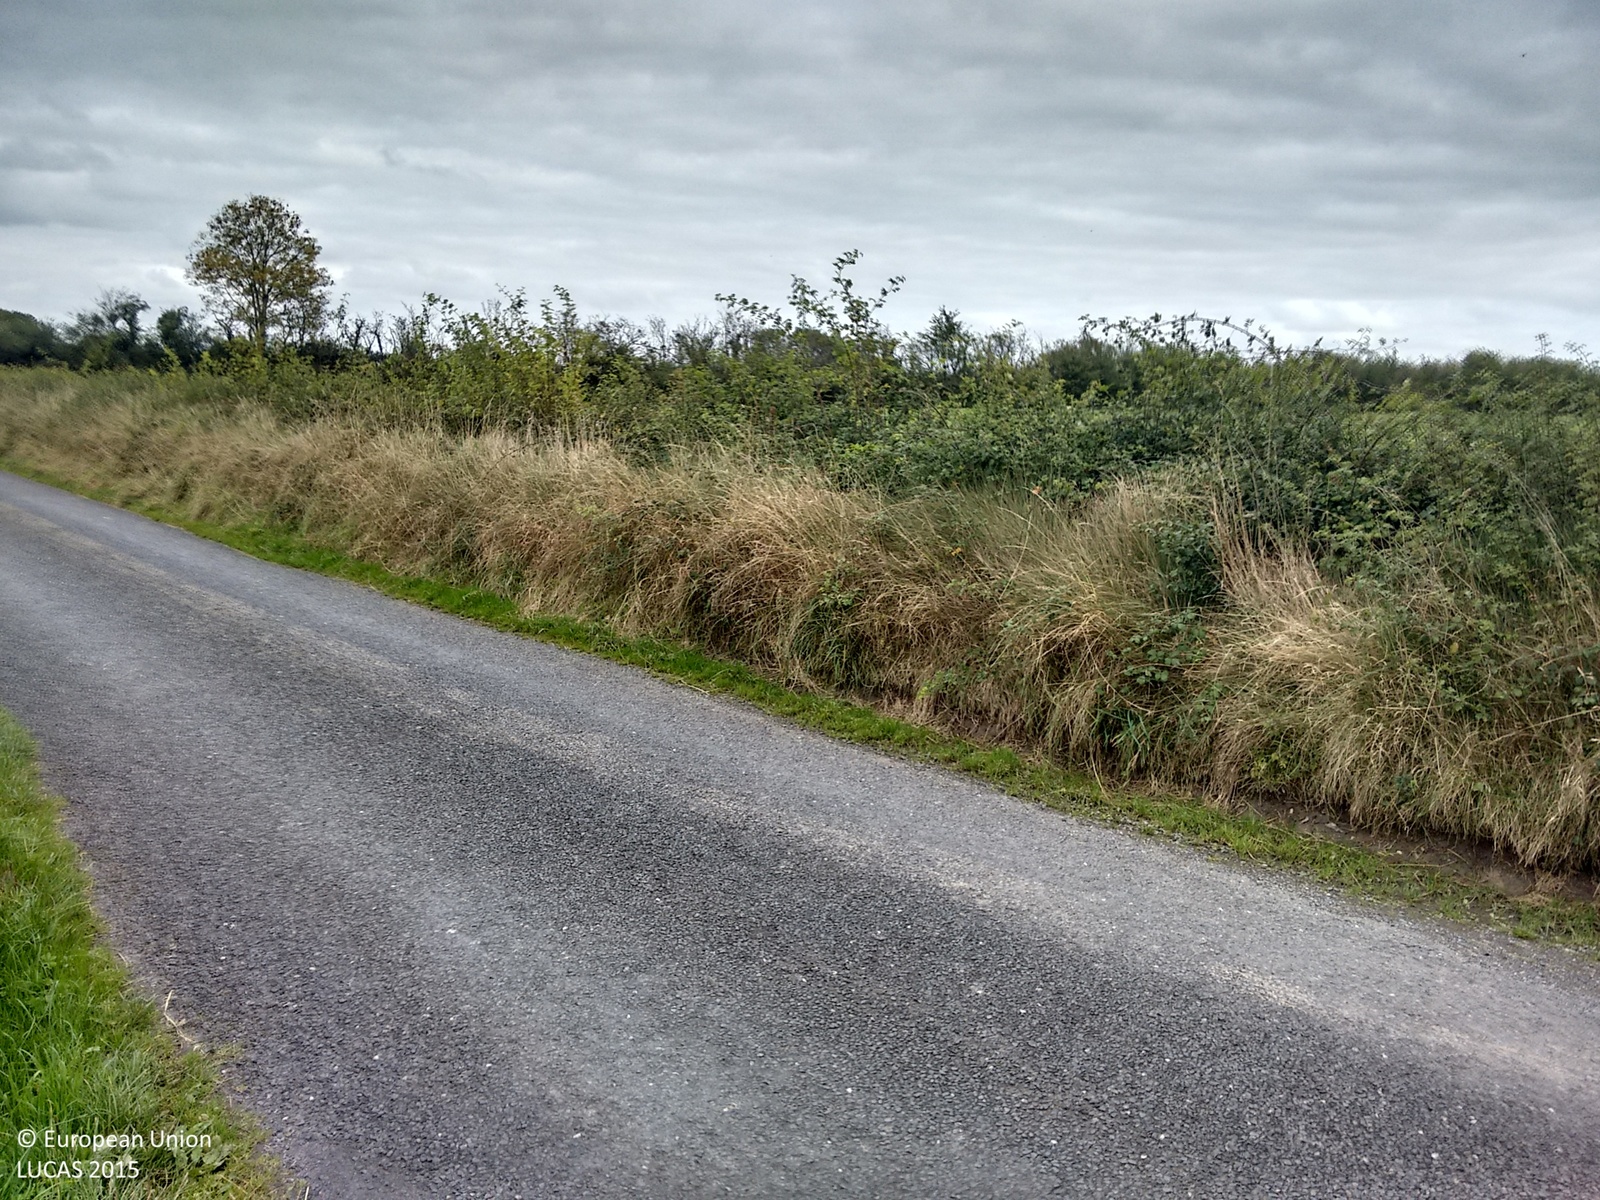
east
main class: Grassland
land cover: Grassland without tree/shrub cover
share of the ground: > 75 %
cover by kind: herbaceous plants 100 %
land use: Agriculture (excluding fallow land and kitchen gardens)
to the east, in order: Grassland without tree/shrub cover; Fences; Ditches and canals; Abandoned hedges; Fences; Grassland without tree/shrub cover; Fences; Ditches and canals; Abandoned hedges; Electric lines; Grass margins; Paved roads, cycling and walking lanes; Abandoned hedges; Grassland without tree/shrub cover; Abandoned hedges; Grassland without tree/shrub cover
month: September
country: IE
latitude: 52.3678
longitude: -8.9361
